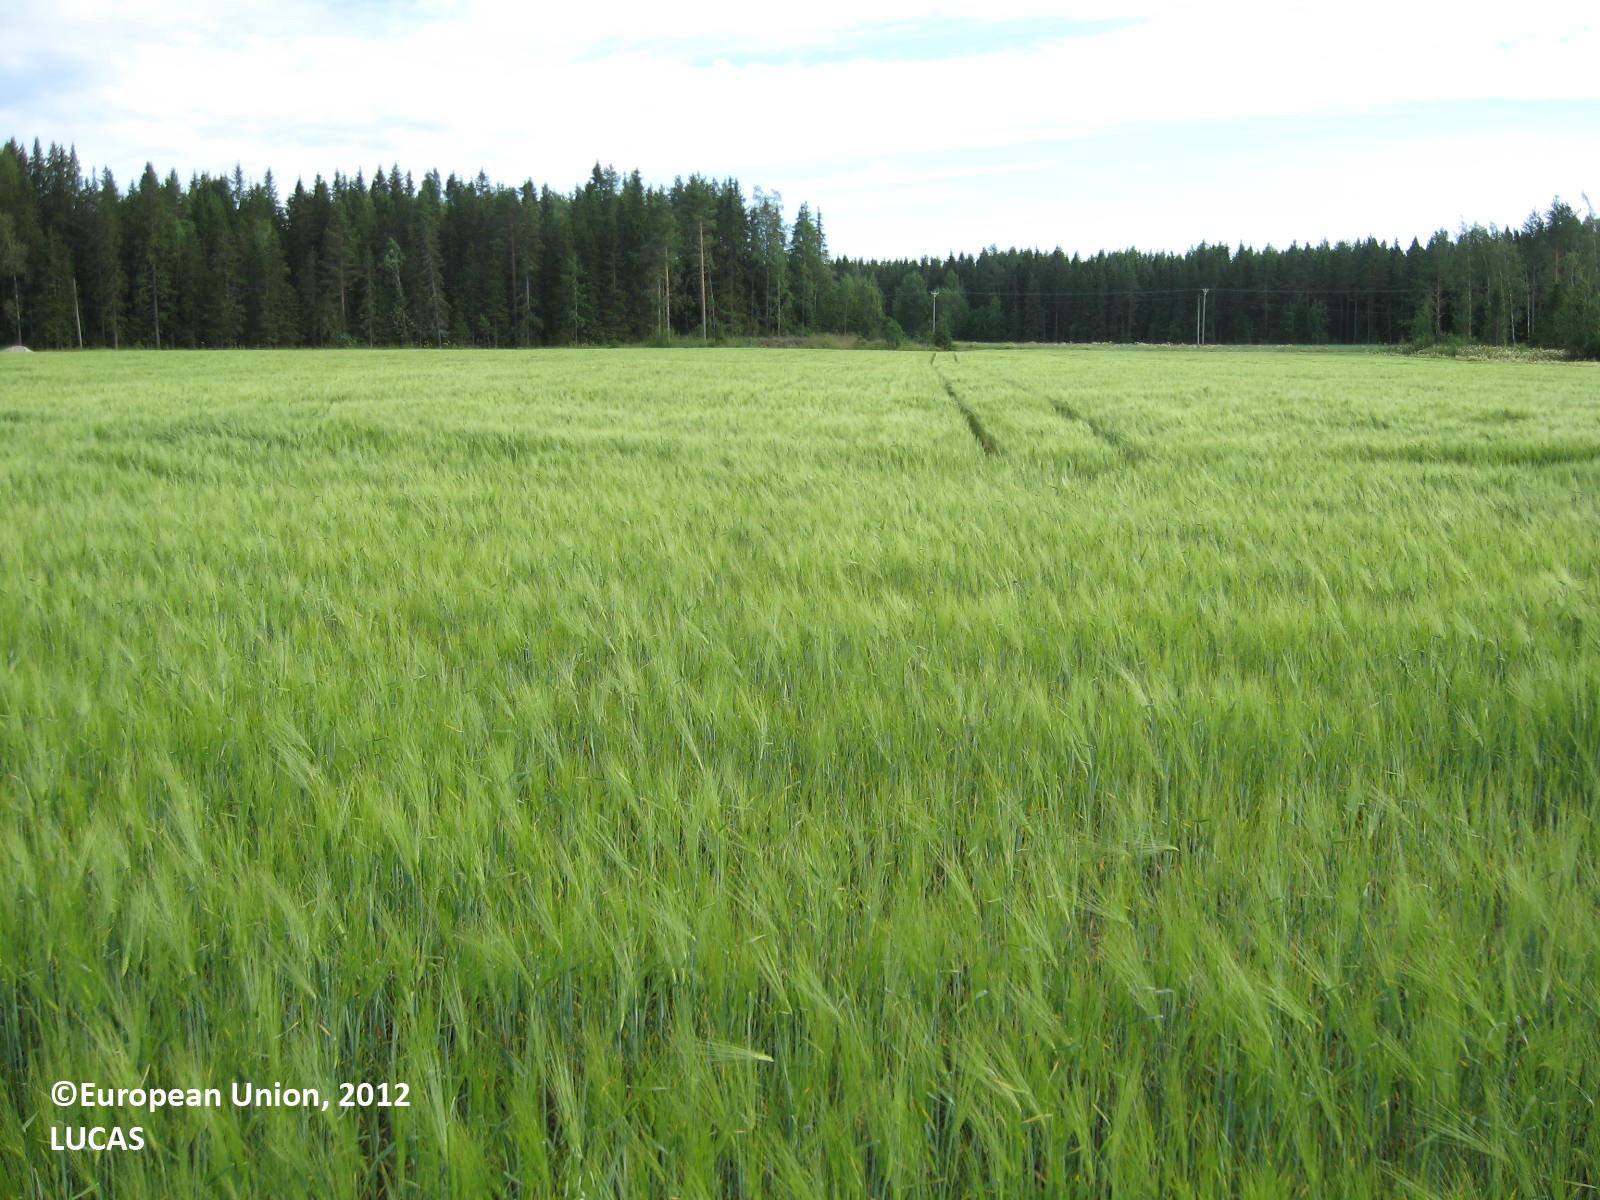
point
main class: Cropland
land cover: Barley
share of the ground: > 75 %
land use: Agriculture (excluding fallow land and kitchen gardens)
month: July
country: FI
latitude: 62.2199
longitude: 21.5664
